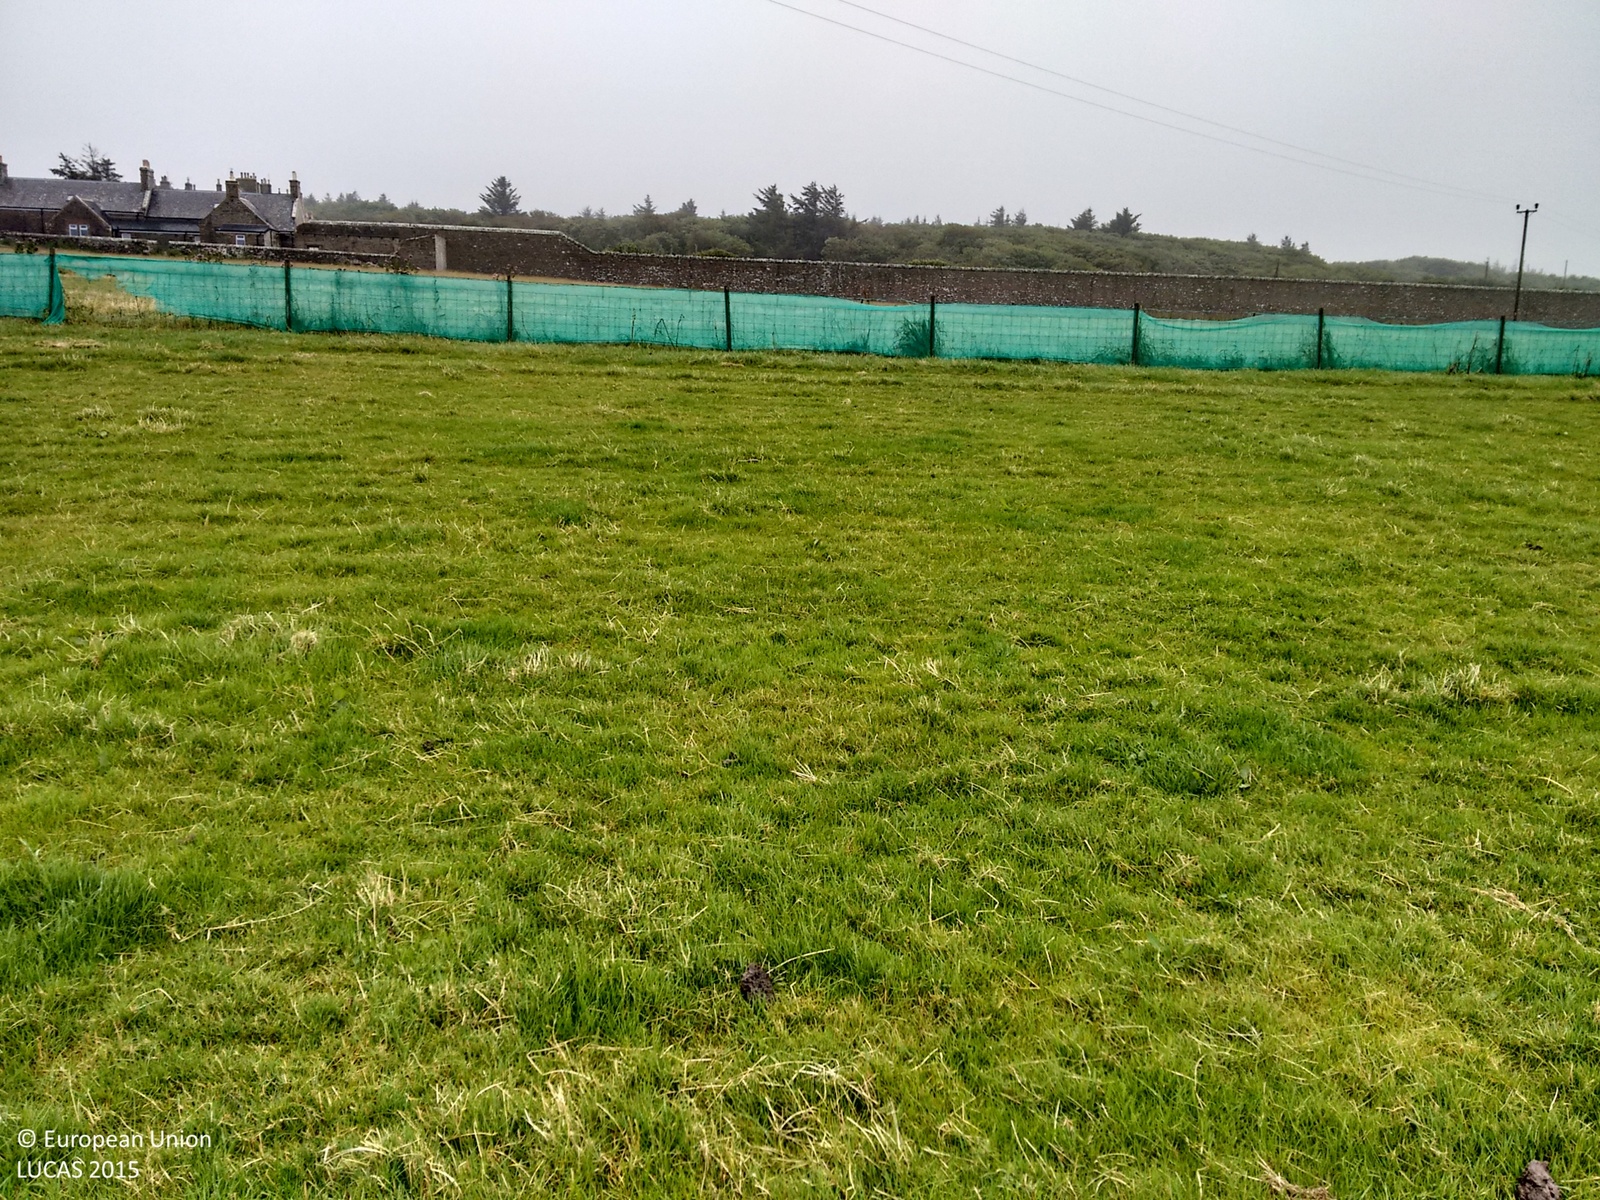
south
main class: Grassland
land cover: Grassland without tree/shrub cover
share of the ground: > 75 %
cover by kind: herbaceous plants 100 %
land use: Agriculture (excluding fallow land and kitchen gardens)
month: September
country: GB
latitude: 58.5635
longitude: -3.8051
